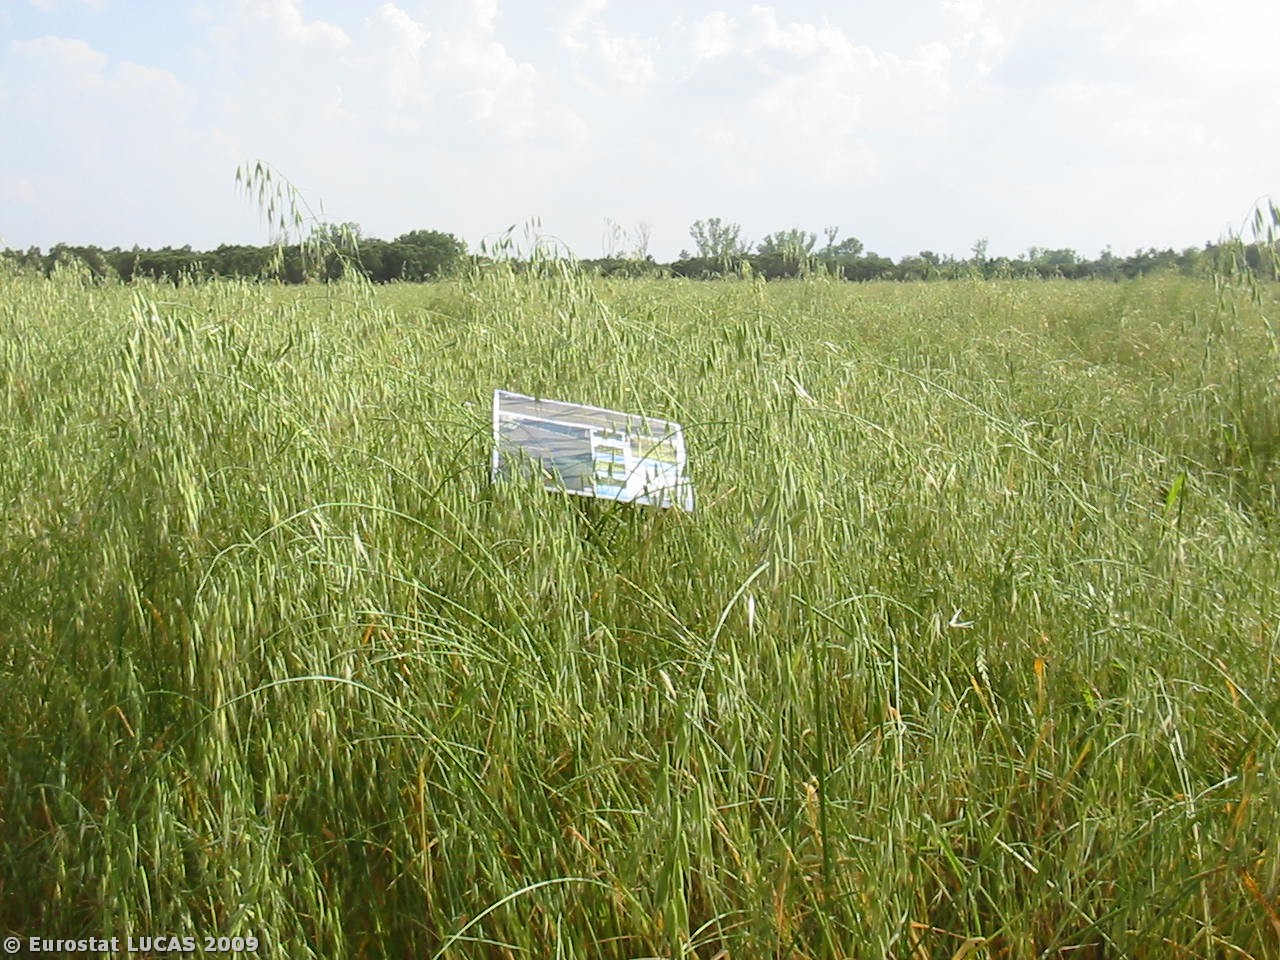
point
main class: Grassland
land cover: Spontaneously vegetated surfaces
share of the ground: > 75 %
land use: Fallow land
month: May
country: IT
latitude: 43.1761
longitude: 11.9994
